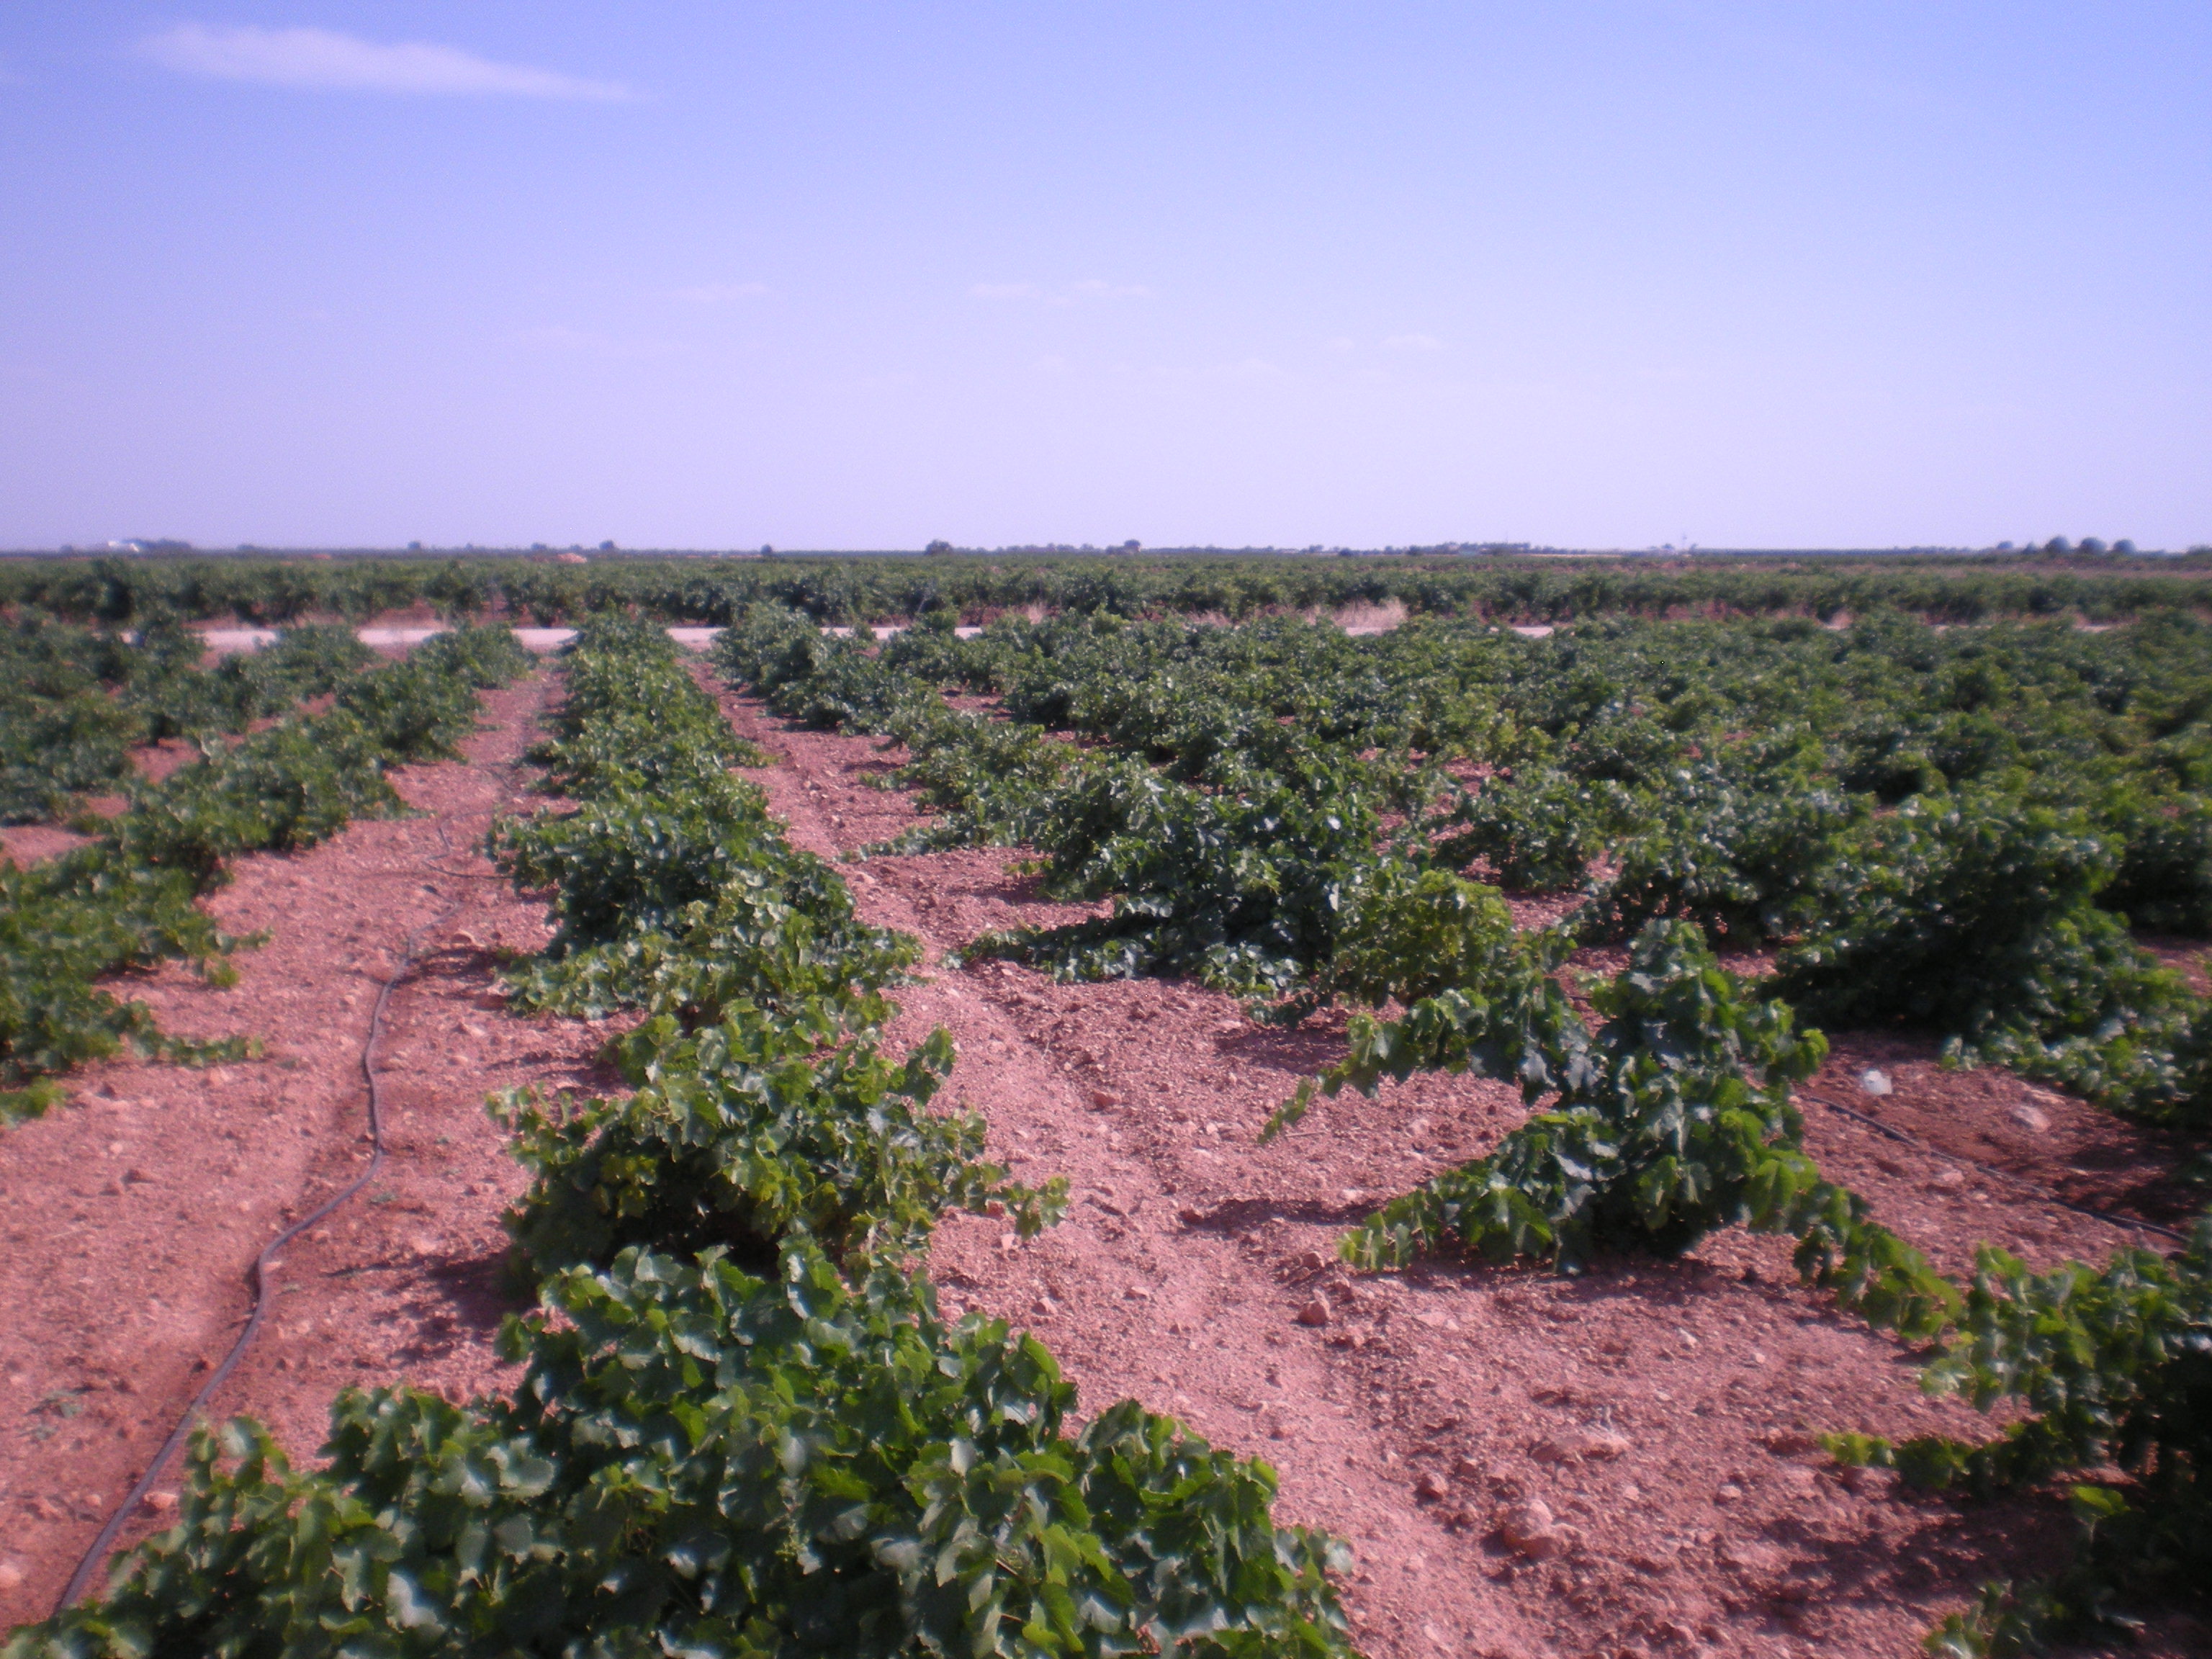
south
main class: Cropland
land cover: Vineyards
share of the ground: 25 - 50 %
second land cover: Other bare soil
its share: > 75 %
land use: Agriculture (excluding fallow land and kitchen gardens)
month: July
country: ES
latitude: 39.4296
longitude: -3.0395
